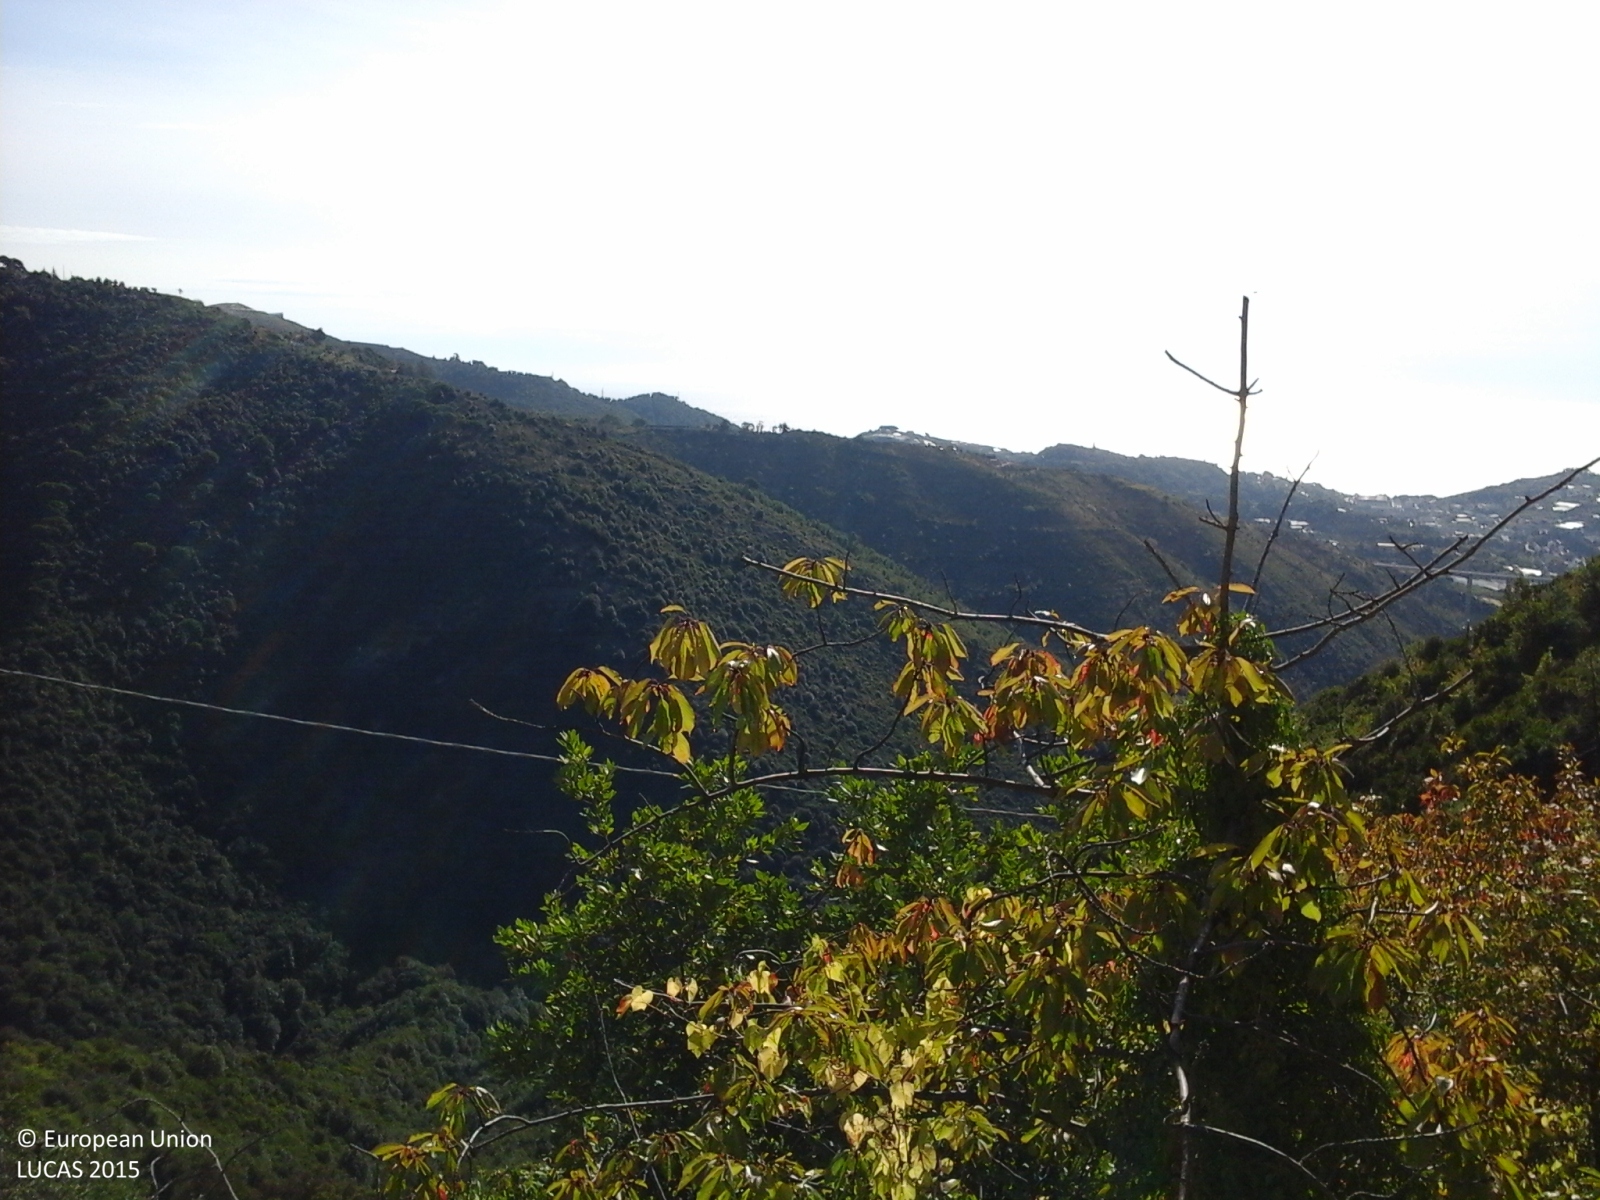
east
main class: Woodland
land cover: Broadleaved woodland
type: thermophilous deciduous forest
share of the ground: > 75 %
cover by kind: broadleaved forest trees 80 %, shrubs 10 %, herbaceous plants 10 %
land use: Semi-natural and natural areas not in use
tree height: > 5 m
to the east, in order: Broadleaved woodland; Electric lines; Broadleaved woodland; Electric lines; Broadleaved woodland; Artificial constructions in urban areas; Broadleaved woodland
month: October
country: IT
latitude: 43.8581
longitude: 7.8033
